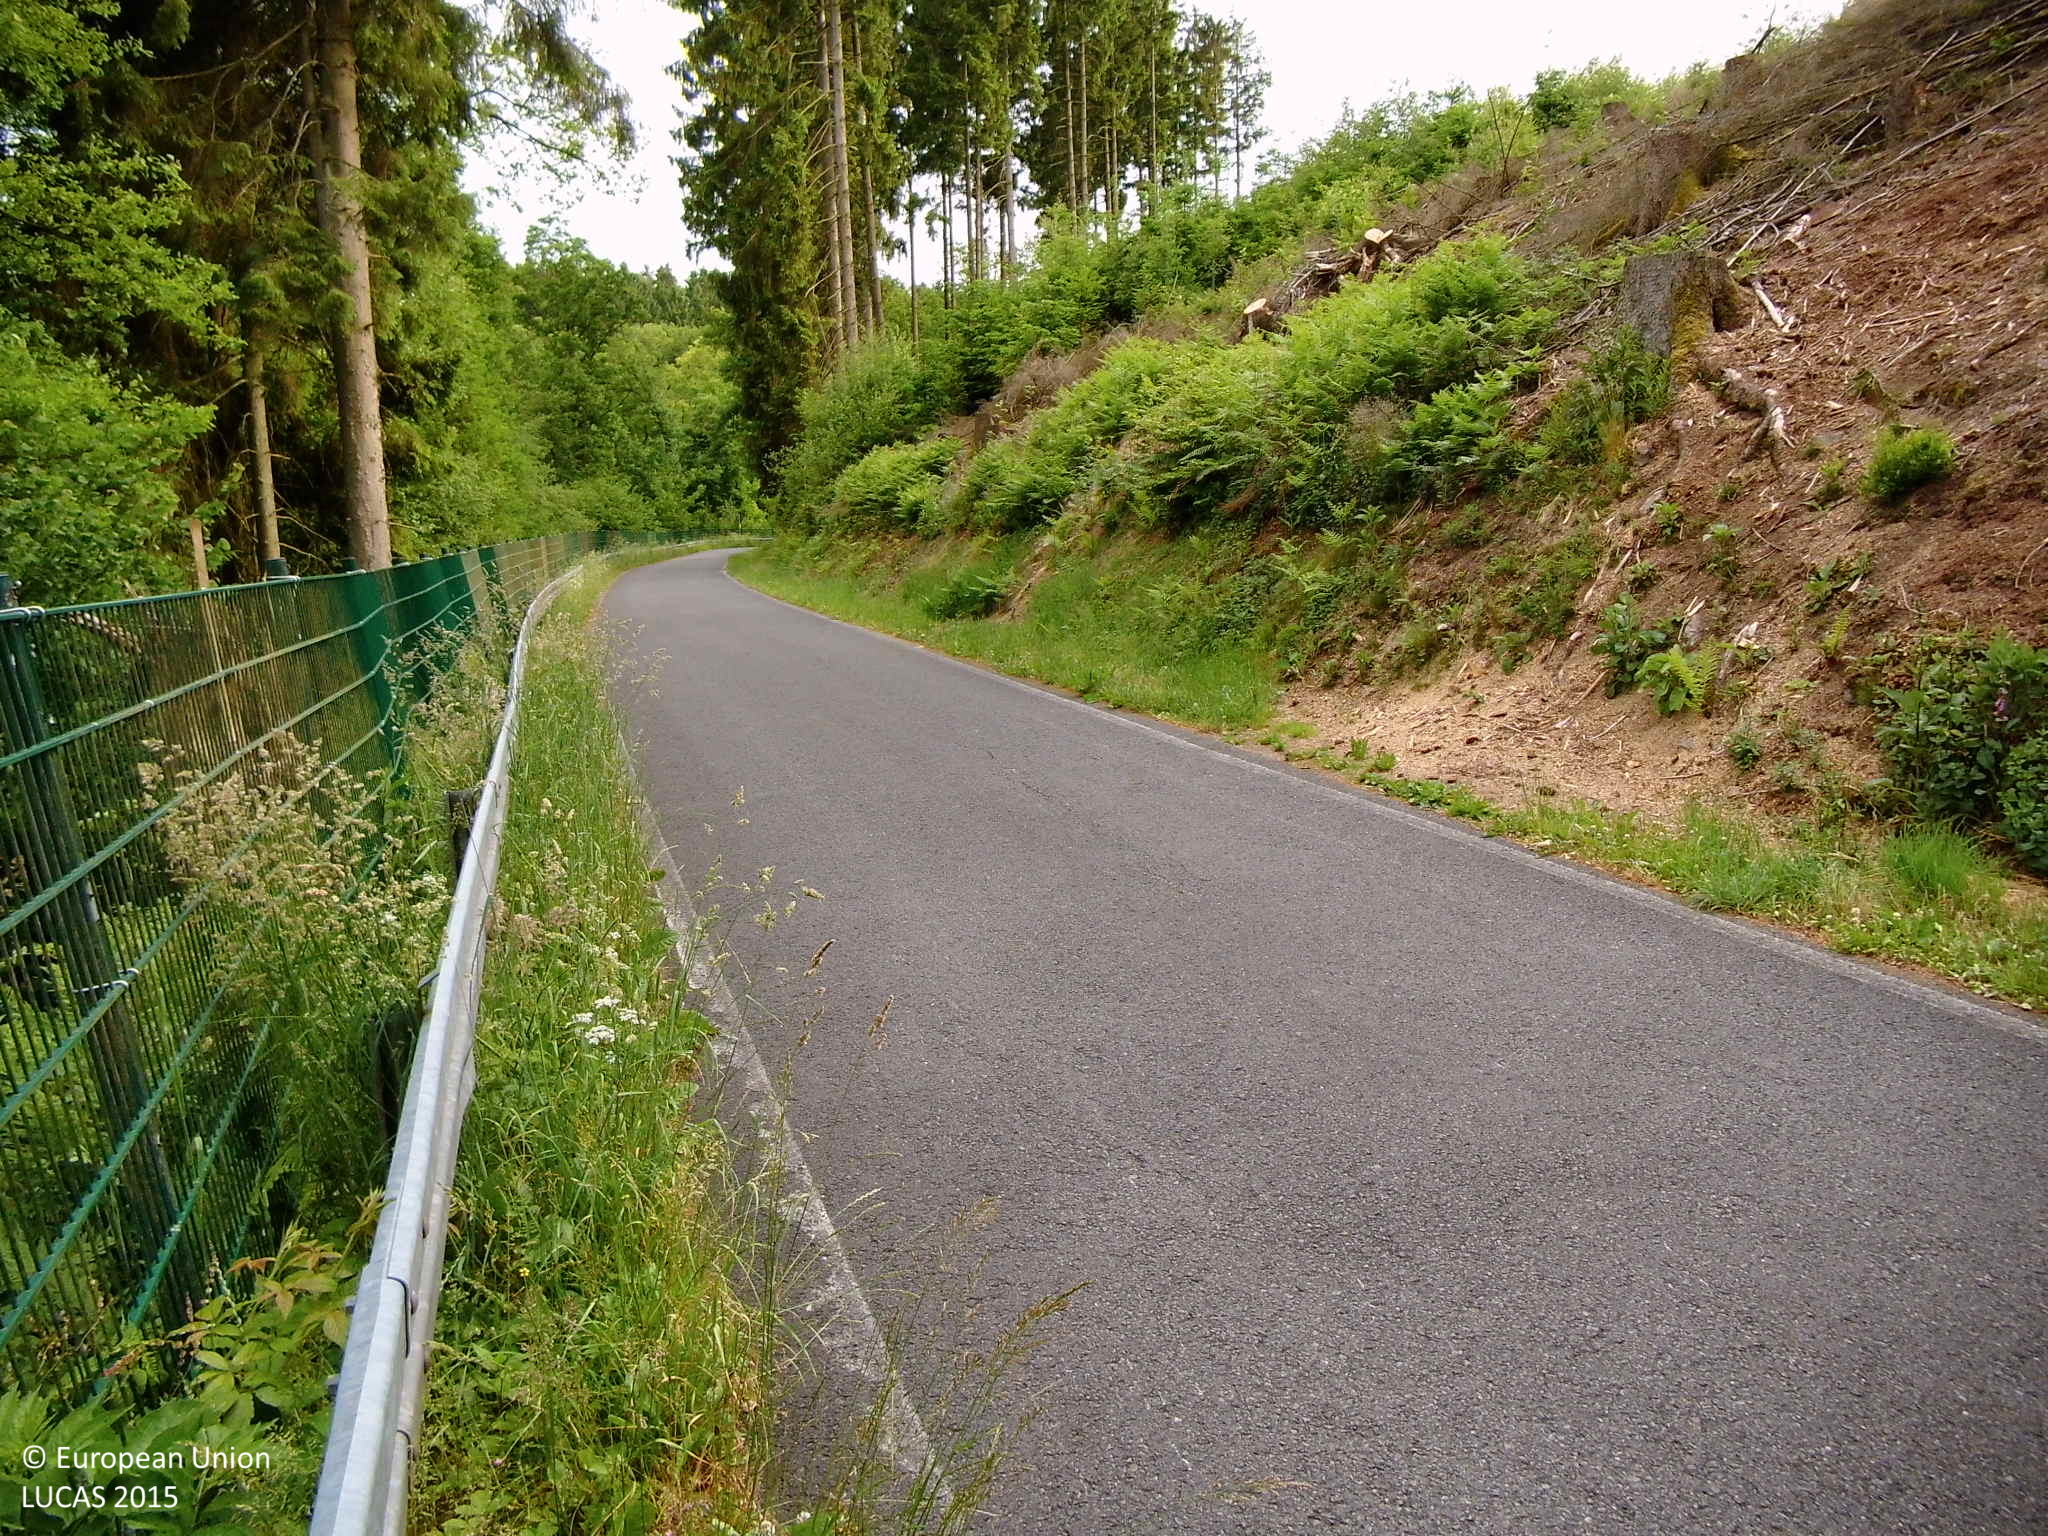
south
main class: Woodland
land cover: Spruce dominated mixed woodland
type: hemiboreal forest and nemoral coniferous forest and mixed broadleaved-coniferous forest
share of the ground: > 75 %
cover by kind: coniferous forest trees 40 %, broadleaved forest trees 35 %, herbaceous plants 10 %, unconsolidated bare surface 10 %, shrubs 5 %
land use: Forestry
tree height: > 5 m
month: June
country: DE
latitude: 51.2341
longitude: 7.4079
